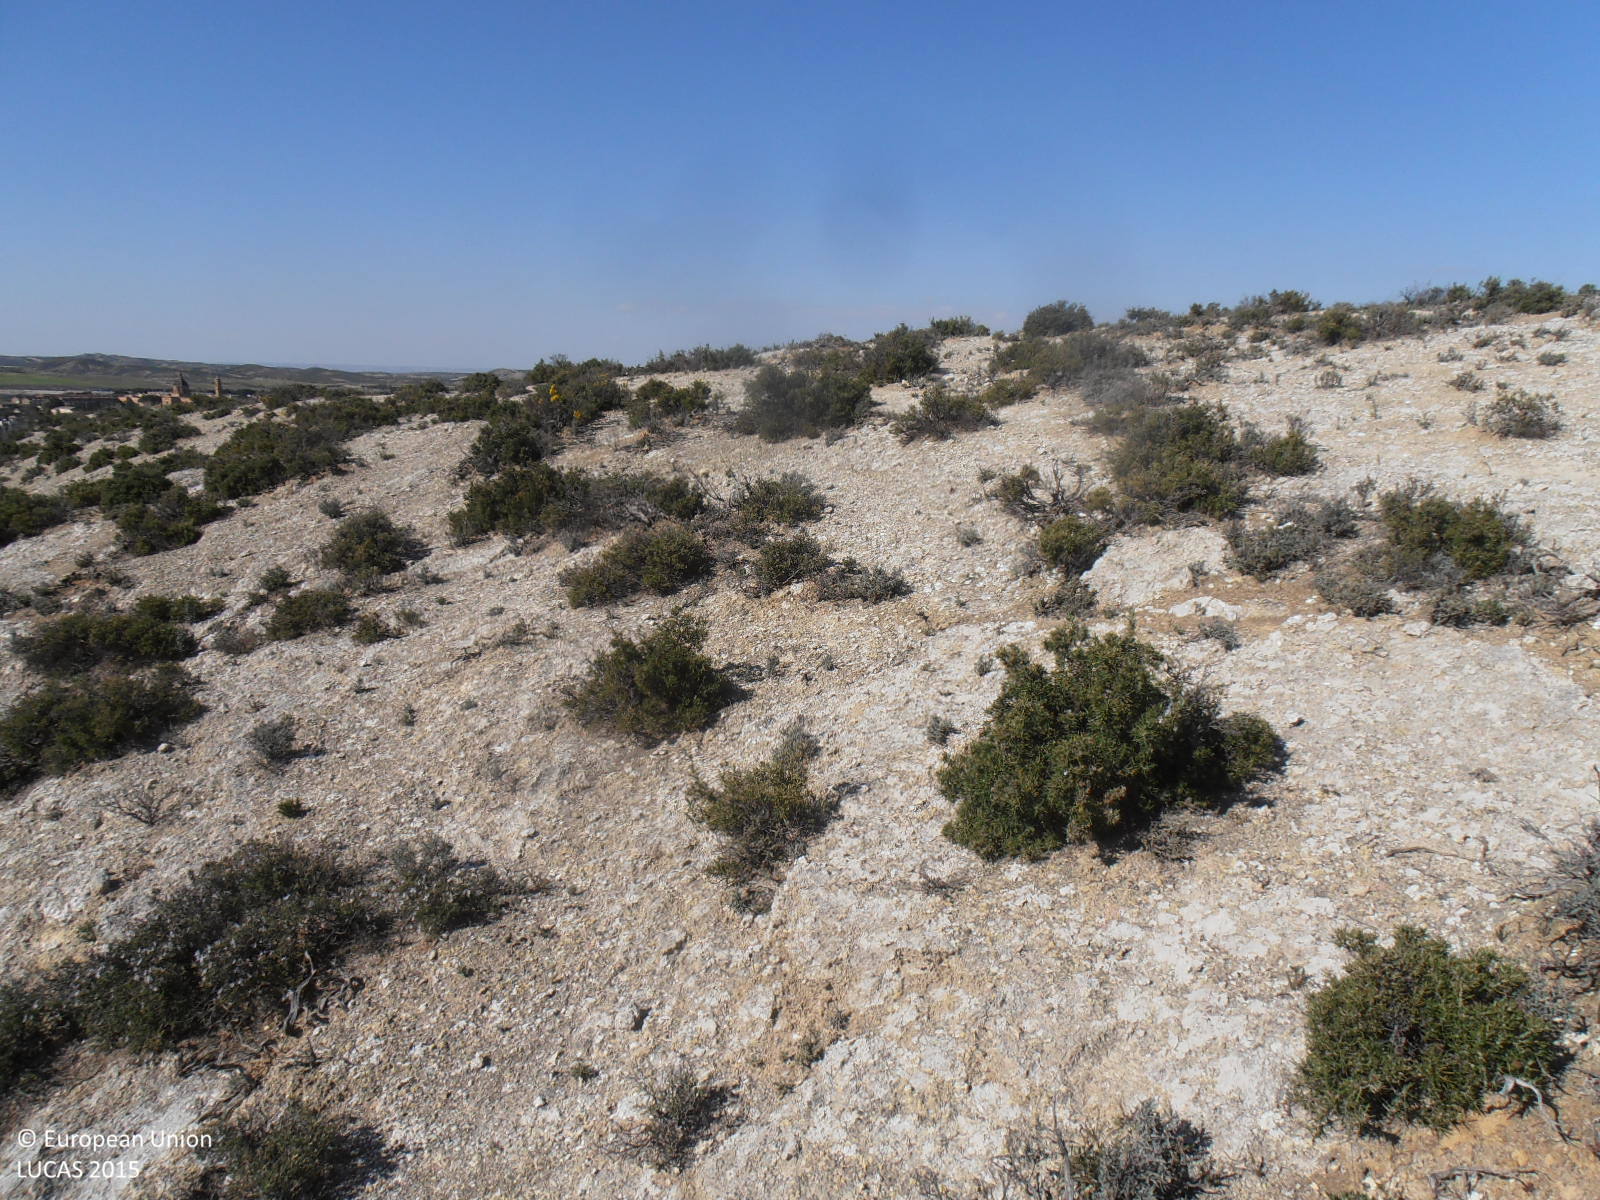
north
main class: Shrubland
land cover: Shrubland without tree cover
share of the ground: > 75 %
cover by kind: consolidated bare surface 75 %, shrubs 25 %
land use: Semi-natural and natural areas not in use
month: April
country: ES
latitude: 41.5672
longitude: -0.9461
